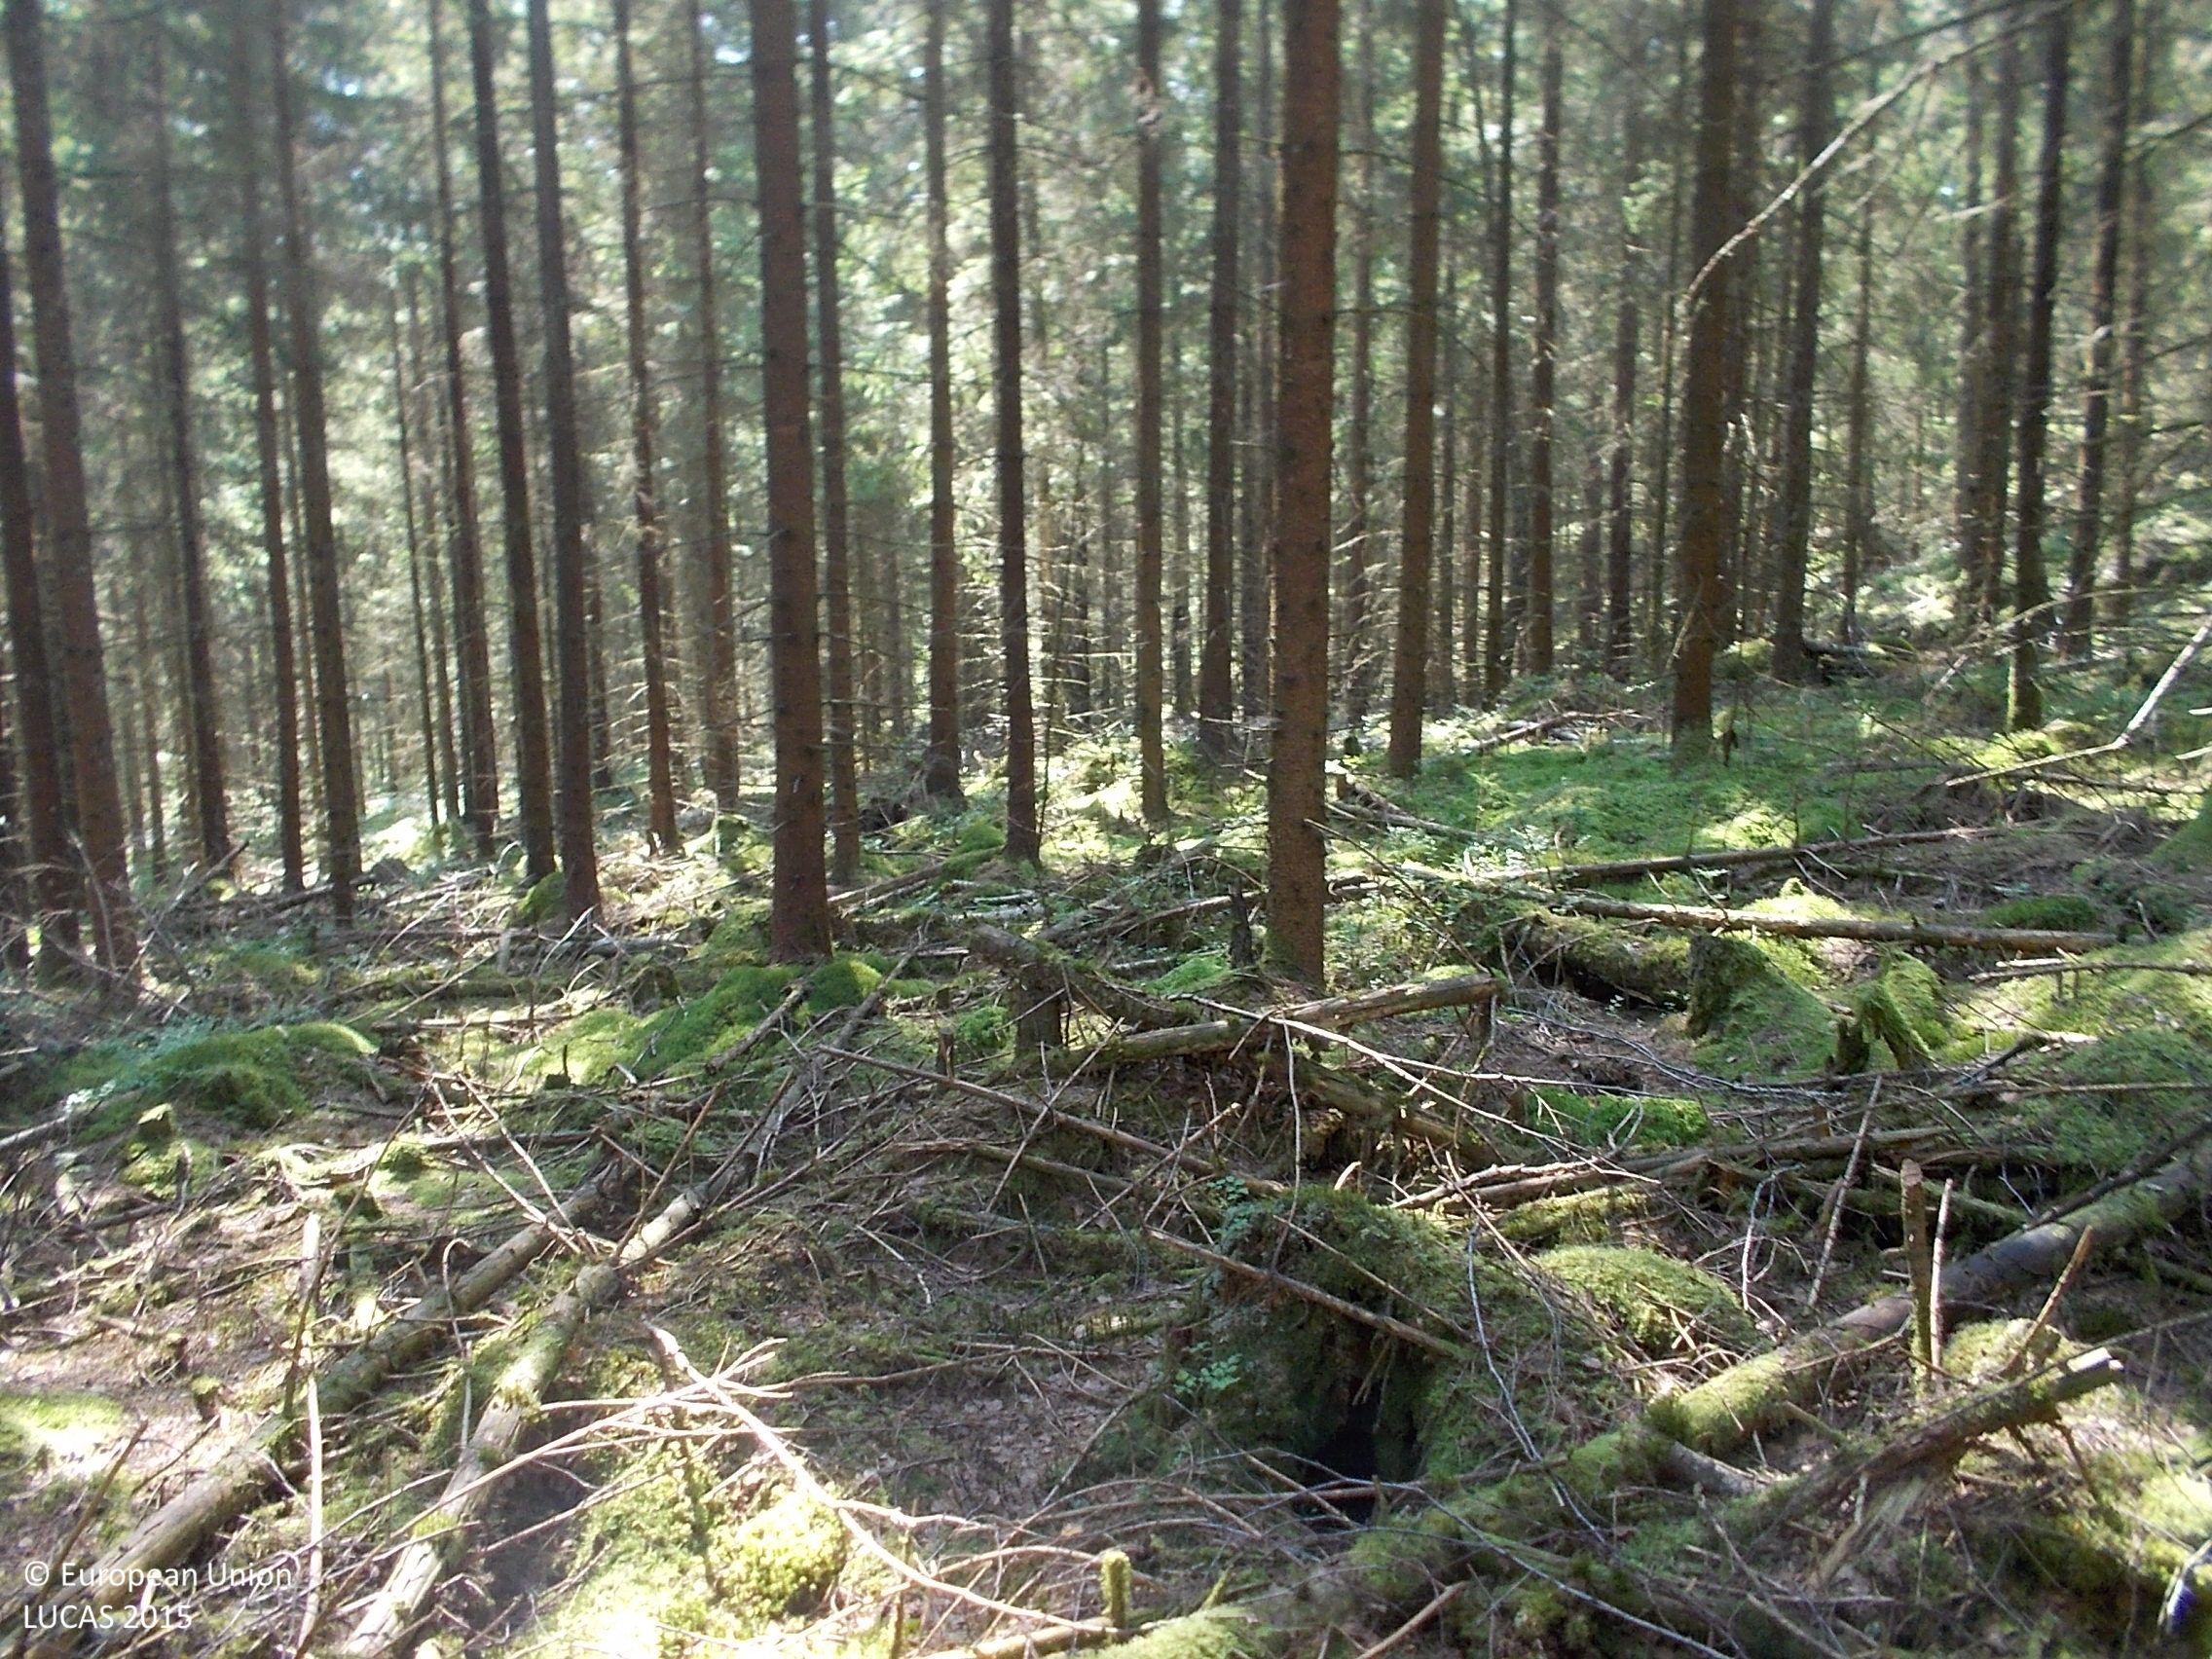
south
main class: Woodland
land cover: Spruce dominated coniferous woodland
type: boreal forest
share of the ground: > 75 %
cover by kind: coniferous forest trees 80 %, shrubs 10 %, lichens and mosses 10 %
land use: Forestry
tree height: > 5 m
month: August
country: SE
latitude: 57.5541
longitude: 13.0874
